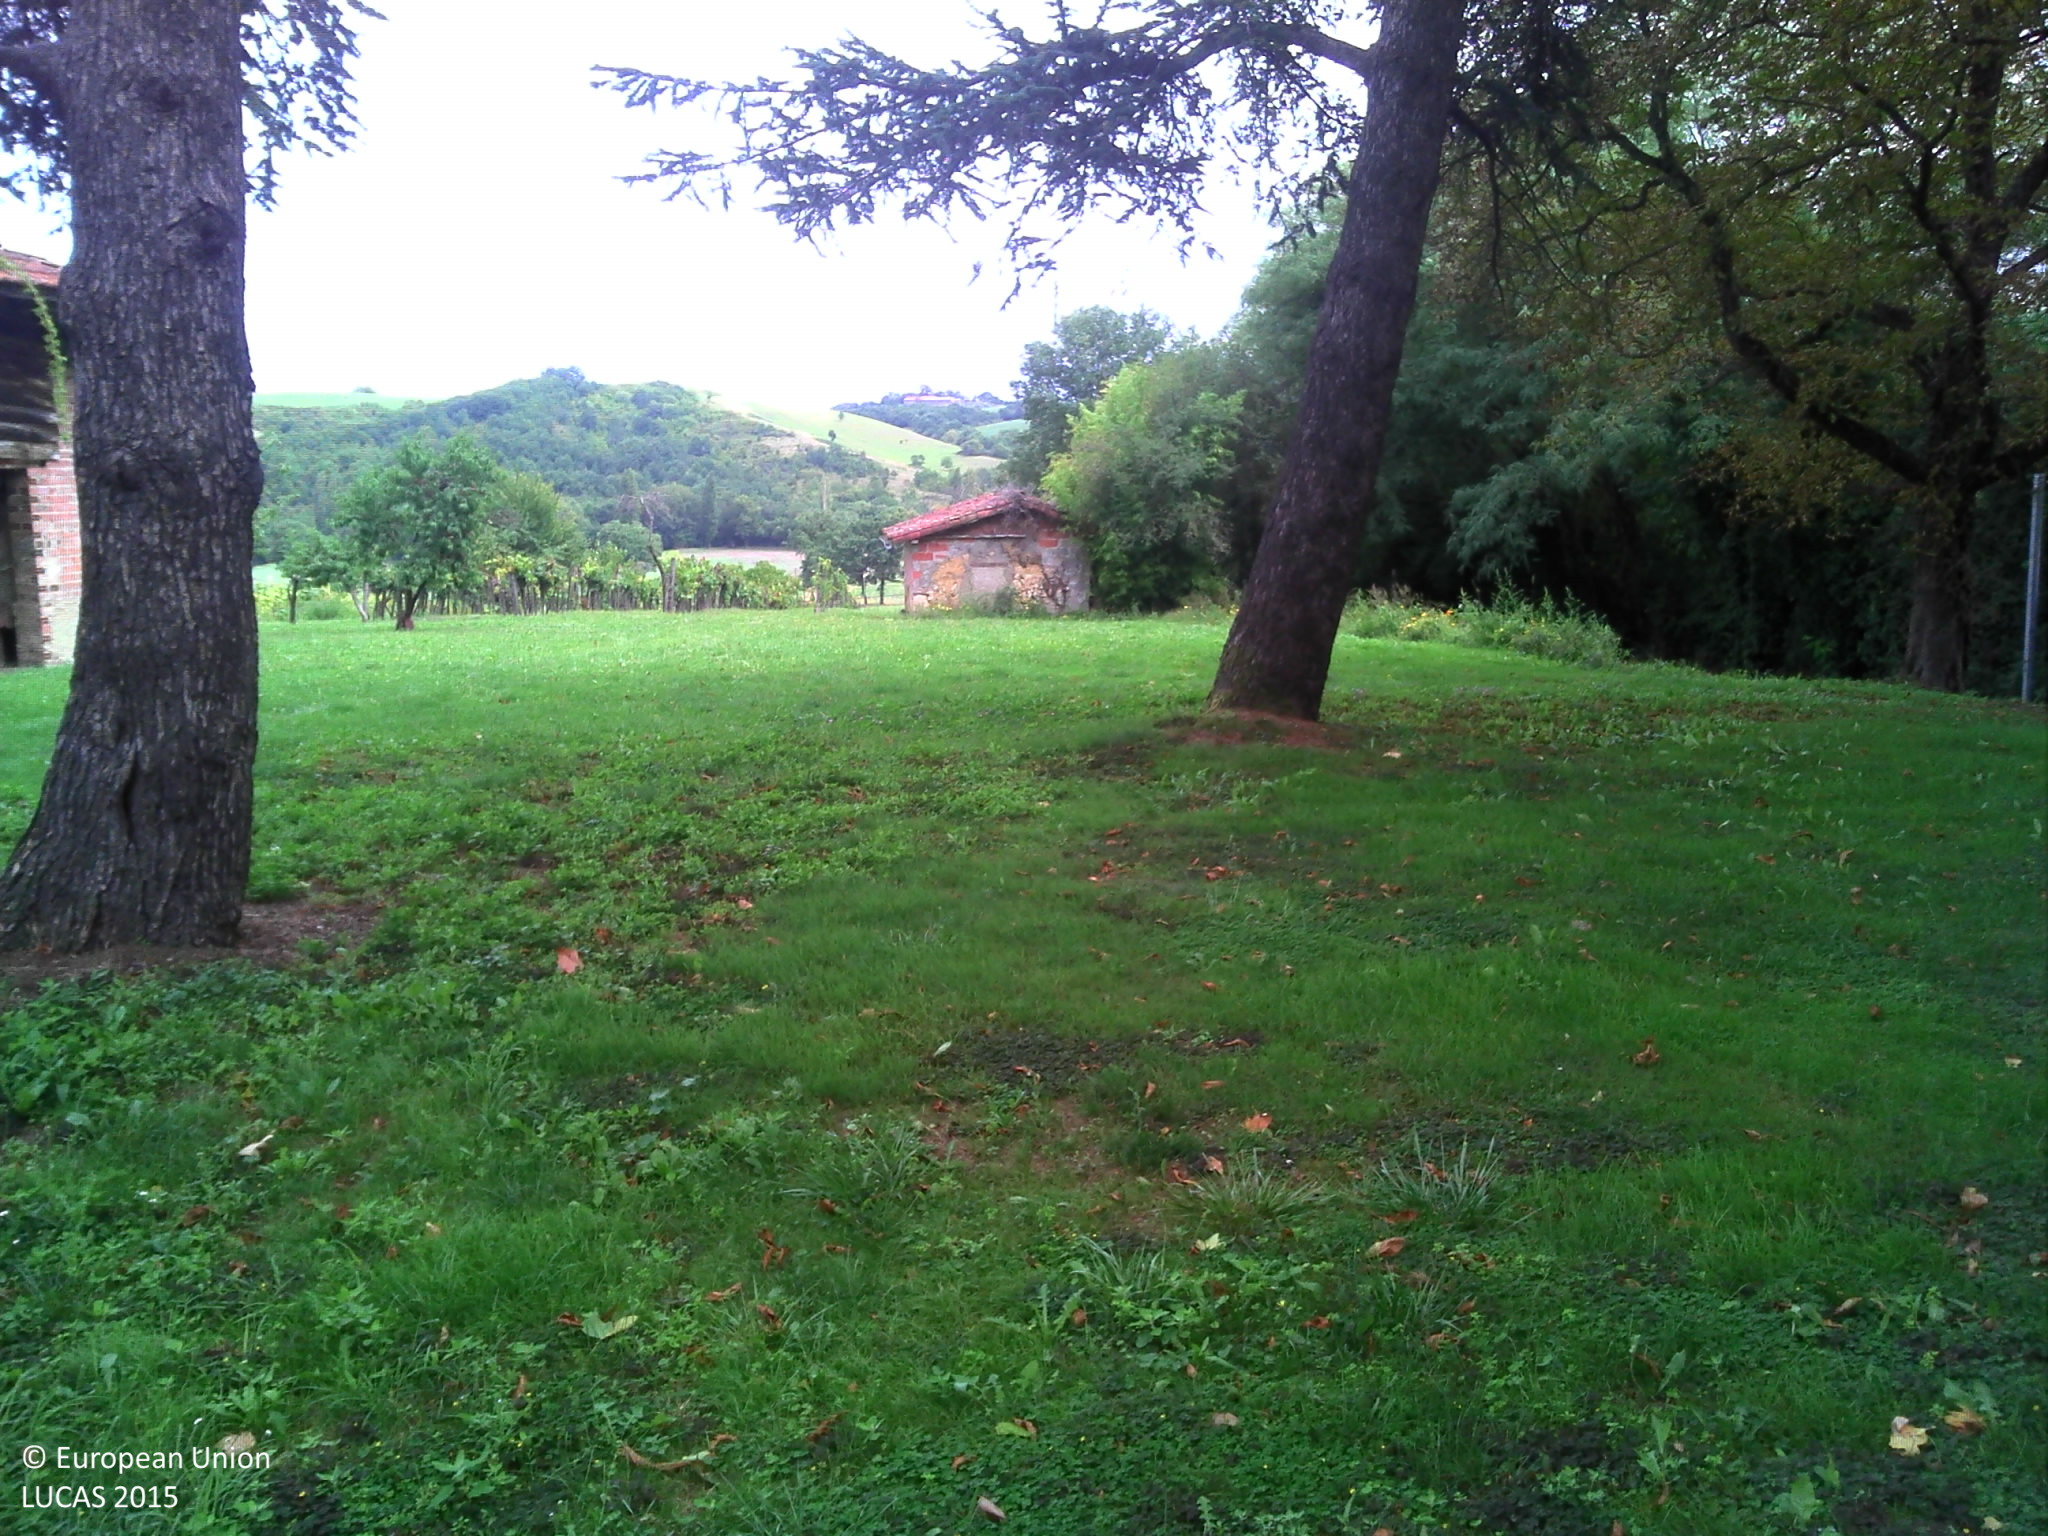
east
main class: Woodland
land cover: Pine dominated mixed woodland
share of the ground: > 75 %
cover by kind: coniferous forest trees 50 %, broadleaved forest trees 25 %, herbaceous plants 25 %
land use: Residential
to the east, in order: Pine dominated mixed woodland; Grassland without tree/shrub cover; Artificial constructions in urban areas; Spontaneously vegetated surfaces; Vineyards; Fences; Shruby margins; Broadleaved woodland; Electric lines; Ditches and canals; Grass margins; Paved roads, cycling and walking lanes; Grass margins; Ditches and canals; Temporary grasslands
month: August
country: FR
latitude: 43.4081
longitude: 0.7261
